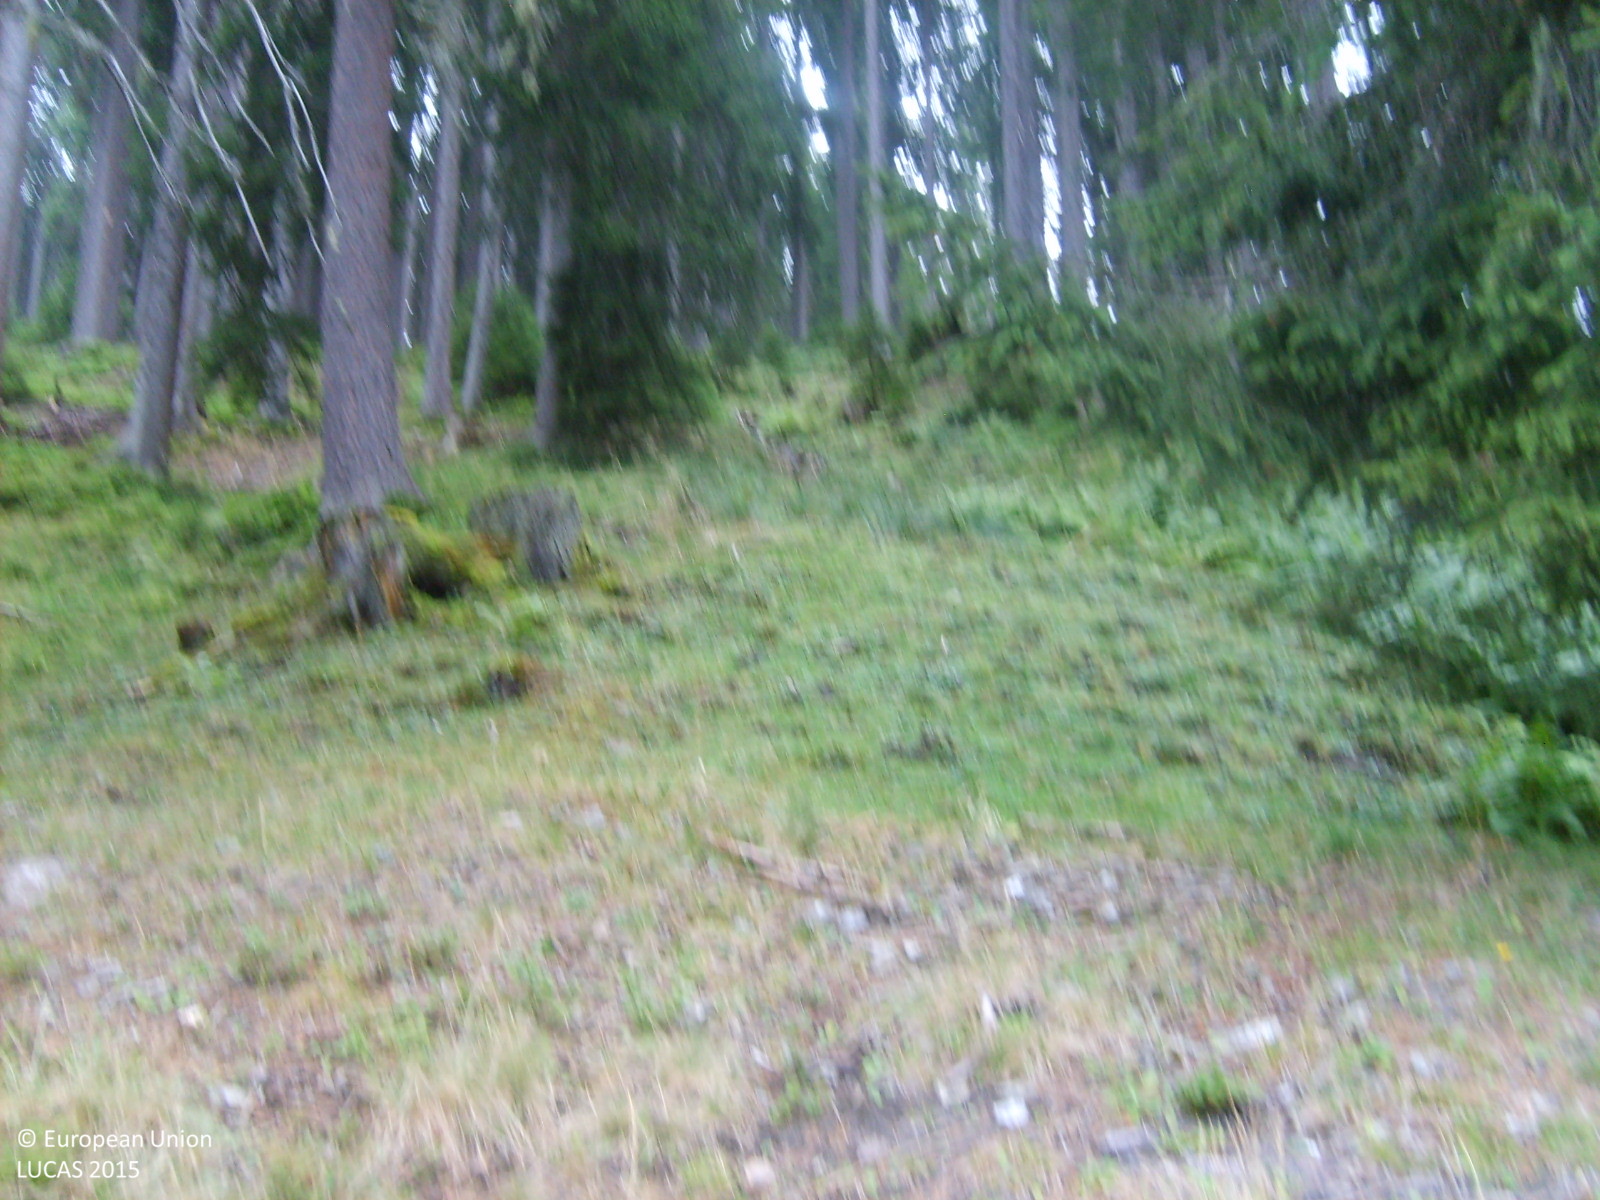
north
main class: Woodland
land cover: Spruce dominated coniferous woodland
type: alpine coniferous forest
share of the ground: > 75 %
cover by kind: coniferous forest trees 85 %, shrubs 10 %, herbaceous plants 5 %
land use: Forestry
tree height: > 5 m
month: September
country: AT
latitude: 47.4111
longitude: 13.5103
